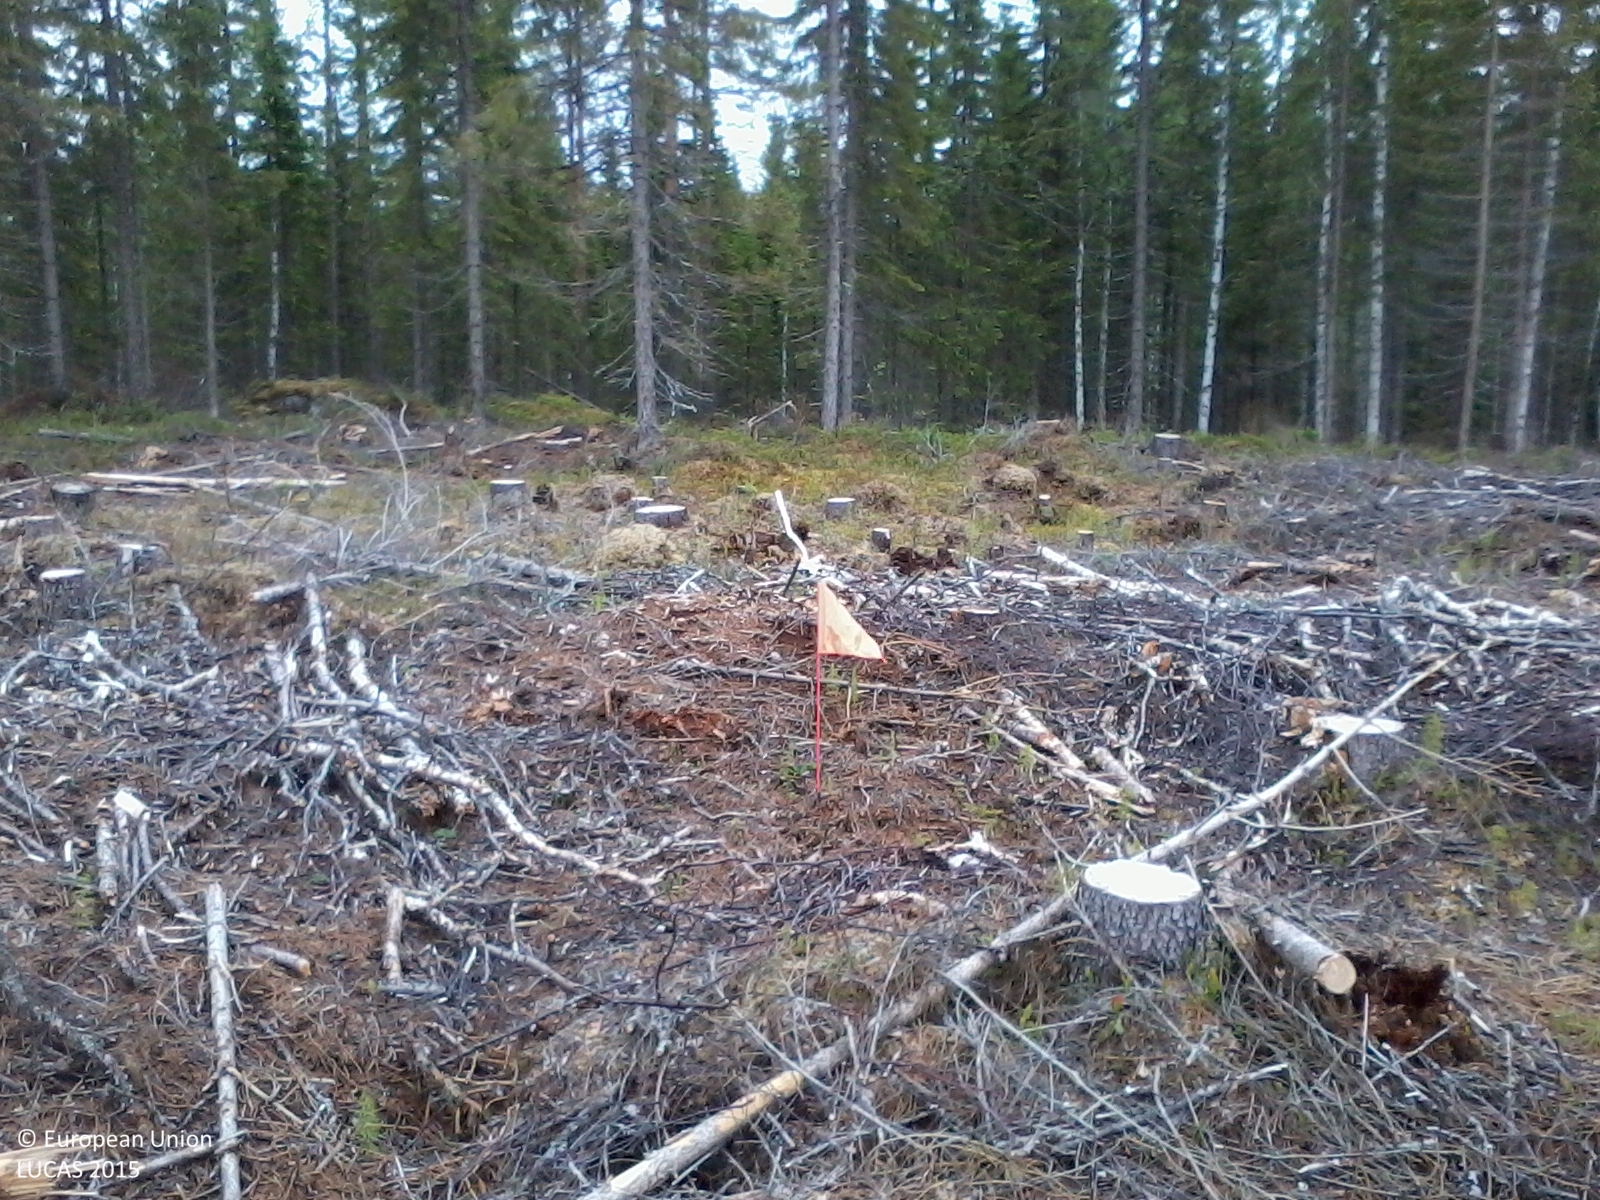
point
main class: Shrubland
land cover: Shrubland without tree cover
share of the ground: 10 - 25 %
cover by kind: shrubs 15 %, herbaceous plants 15 %, lichens and mosses 15 %, consolidated bare surface 10 %
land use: Forestry
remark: Clear cut
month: June
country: SE
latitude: 63.4351
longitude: 17.9720
